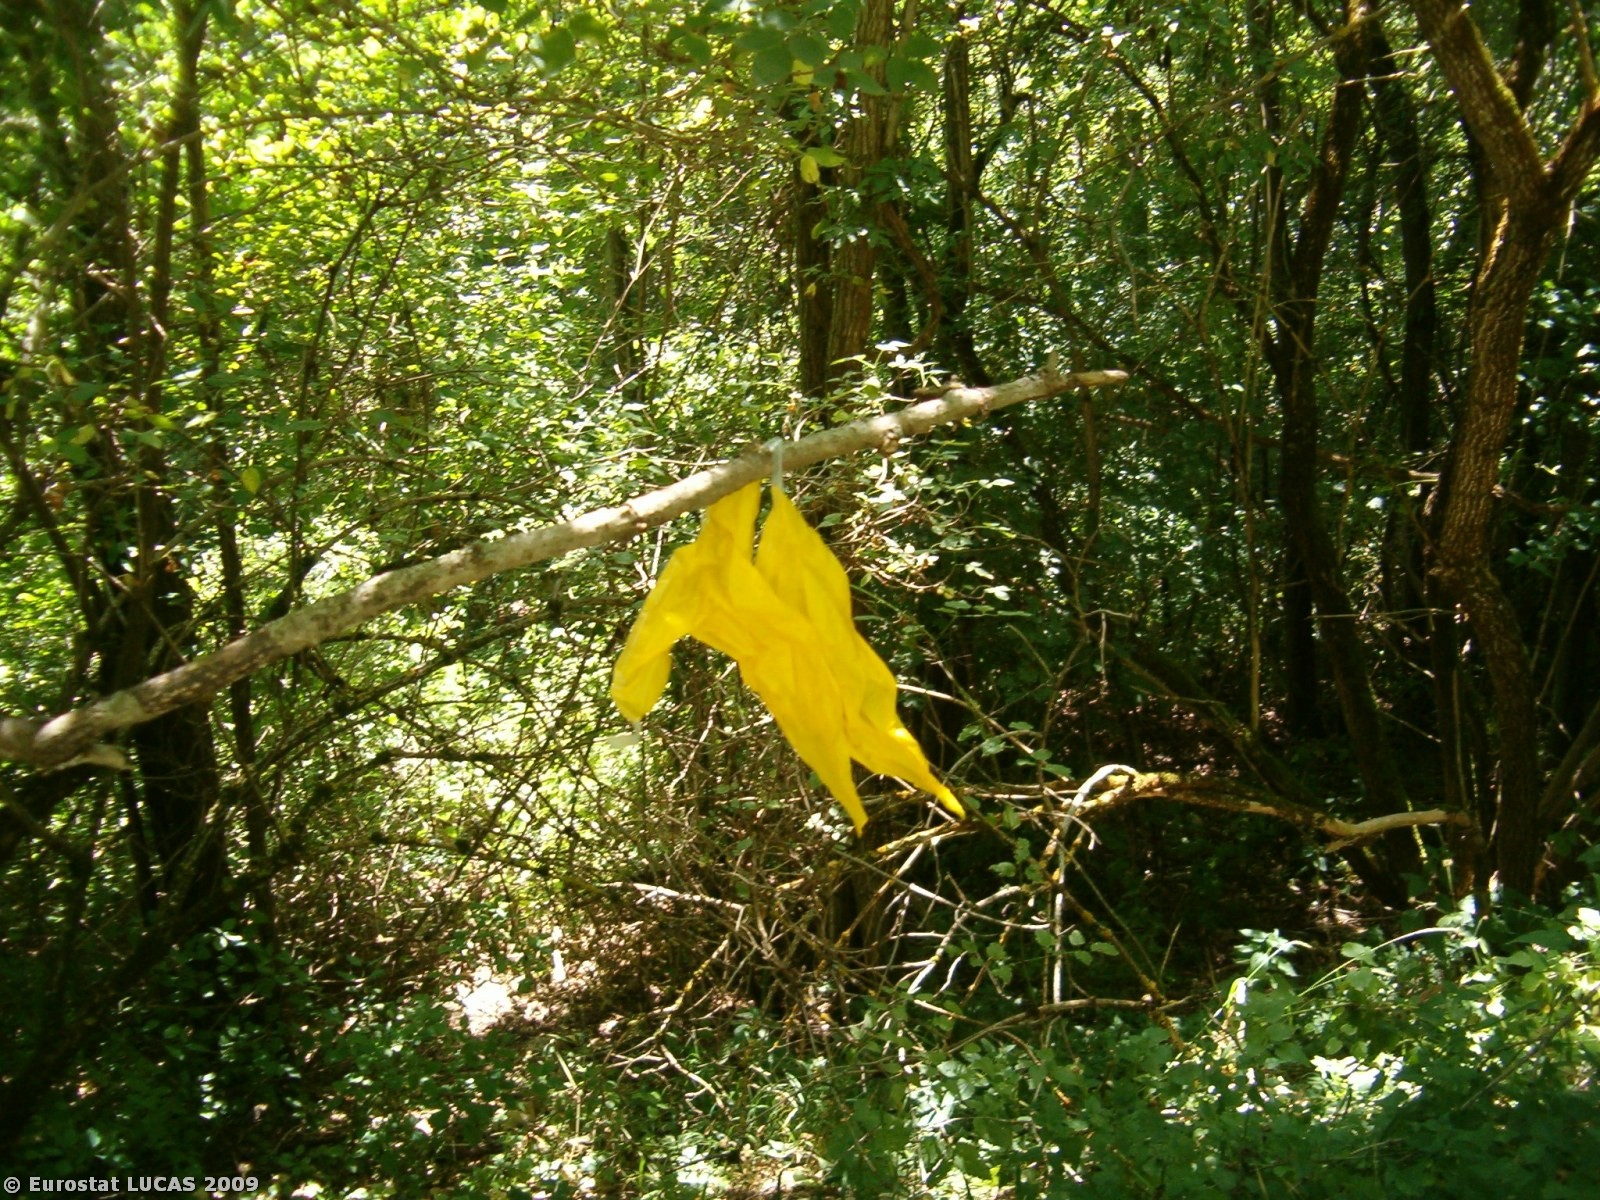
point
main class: Woodland
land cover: Broadleaved woodland
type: thermophilous deciduous forest
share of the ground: > 75 %
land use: Forestry
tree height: > 5 m
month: July
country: IT
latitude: 42.4036
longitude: 13.2336
